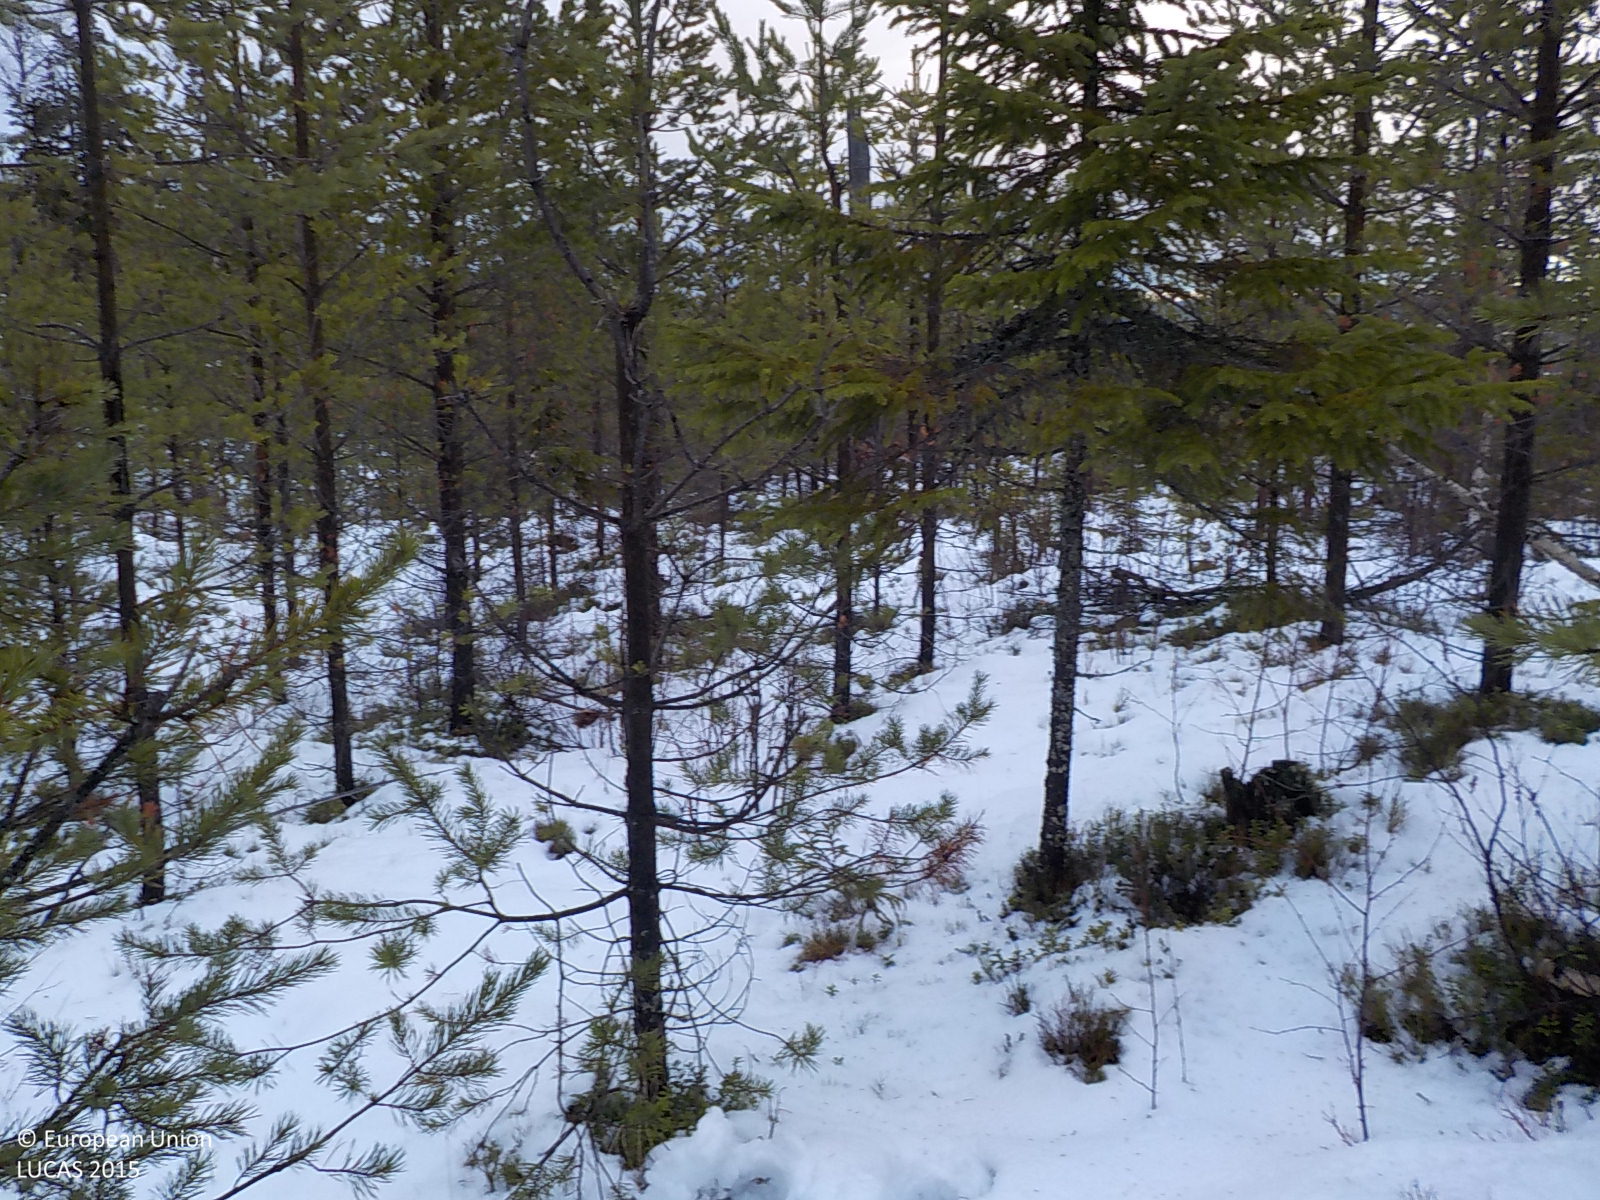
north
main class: Woodland
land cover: Pine dominated coniferous woodland
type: boreal forest
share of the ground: 50 - 75 %
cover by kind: coniferous forest trees 70 %, shrubs 15 %, lichens and mosses 10 %, broadleaved forest trees 5 %
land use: Forestry
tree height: < 5 m
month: December
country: SE
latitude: 63.4595
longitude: 16.6938
